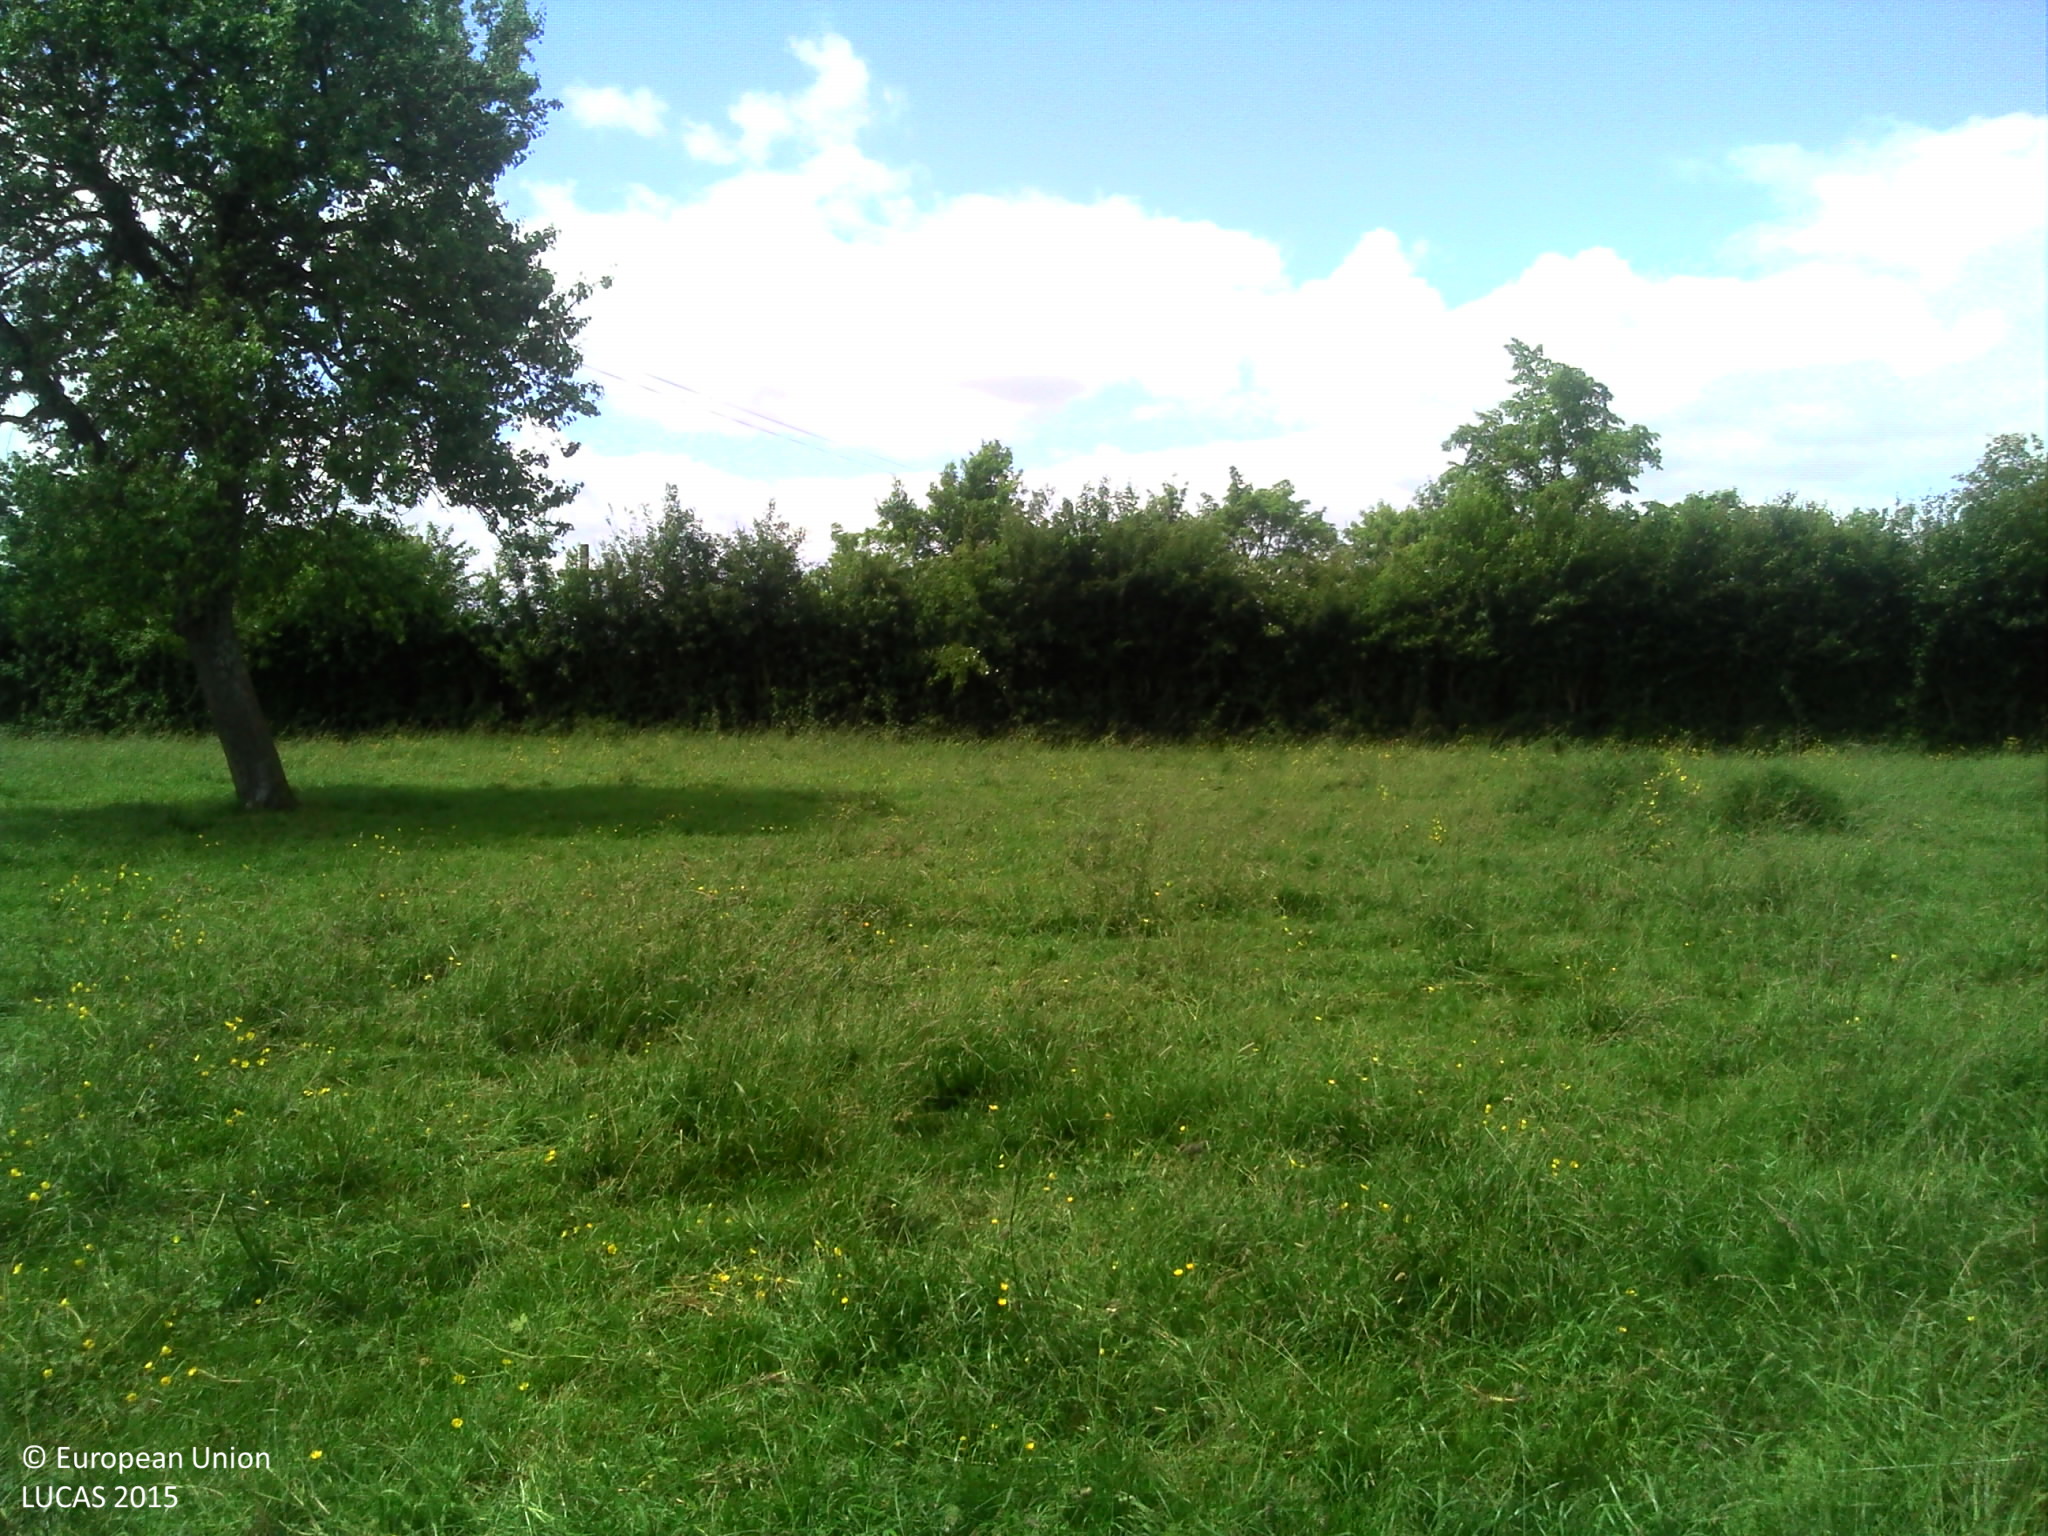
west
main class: Grassland
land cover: Grassland without tree/shrub cover
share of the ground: > 75 %
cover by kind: herbaceous plants 95 %
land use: Agriculture (excluding fallow land and kitchen gardens)
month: June
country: FR
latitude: 48.8763
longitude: 0.0299
